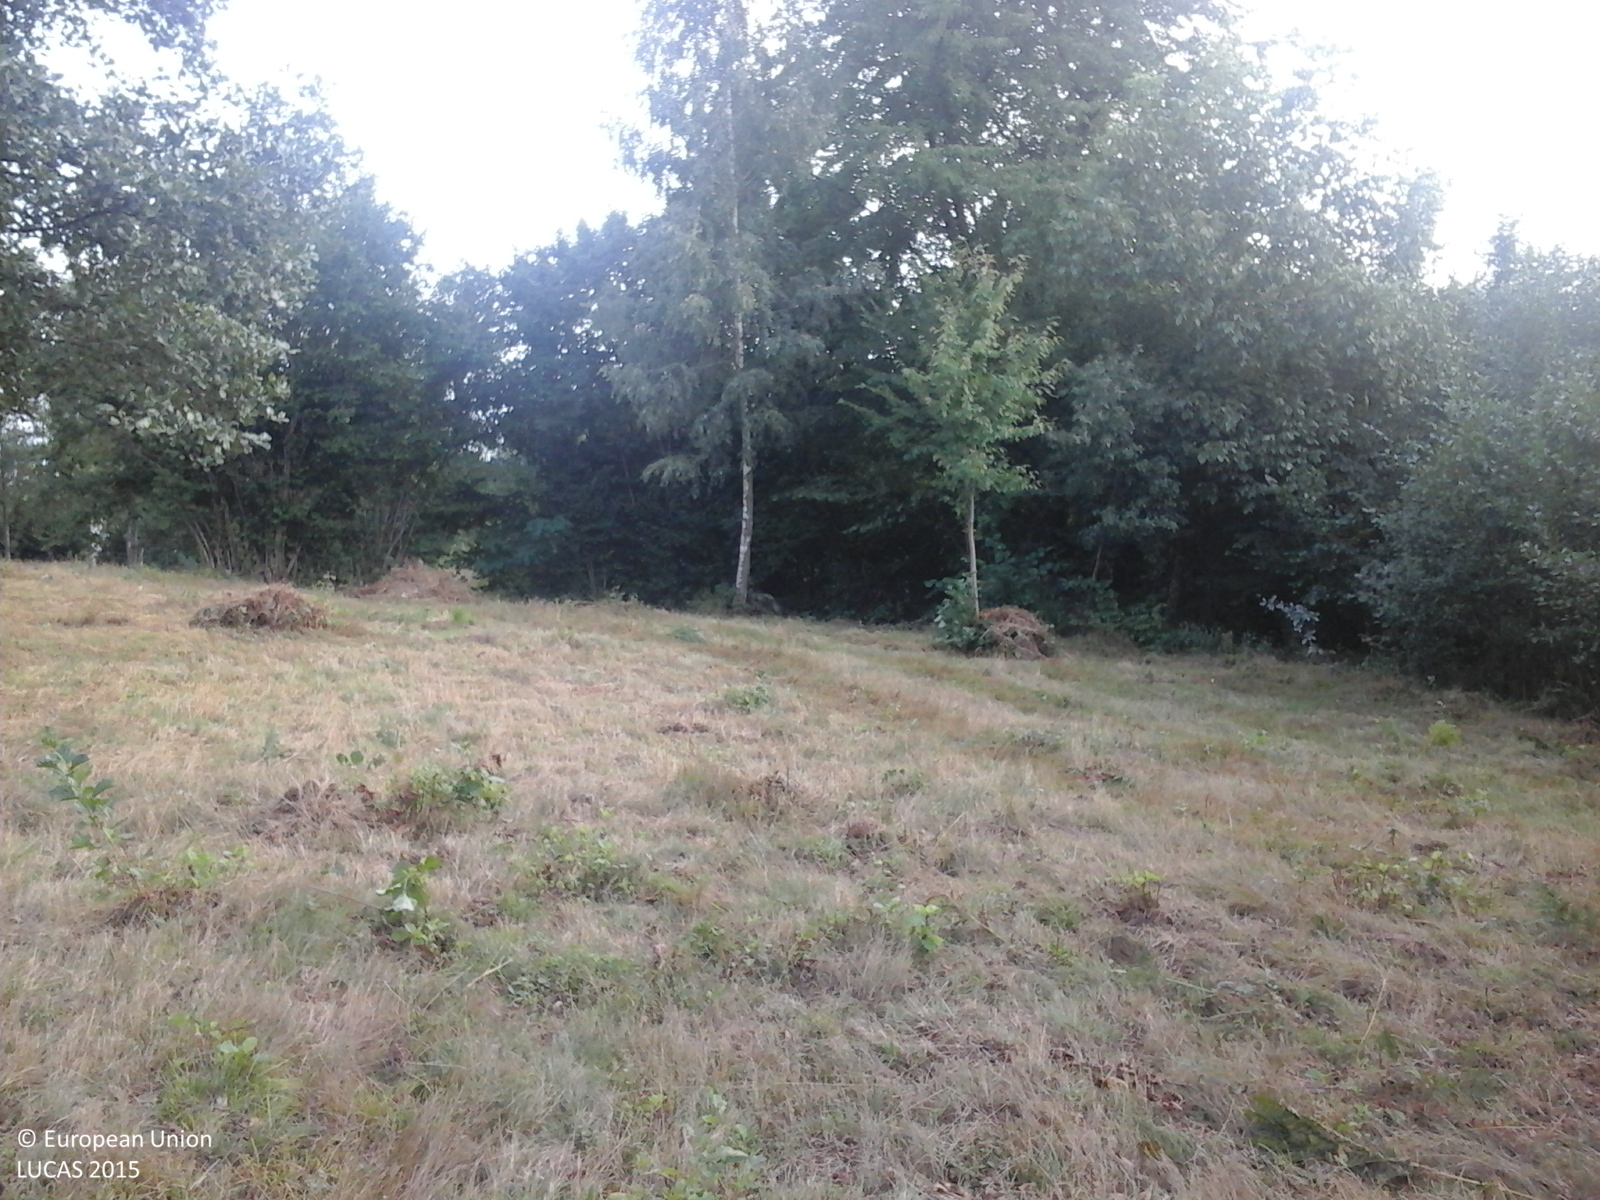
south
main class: Grassland
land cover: Grassland with sparse tree/shrub cover
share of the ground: > 75 %
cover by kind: herbaceous plants 85 %, shrubs 10 %, broadleaved forest trees 5 %
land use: Agriculture (excluding fallow land and kitchen gardens)
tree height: > 5 m
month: September
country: RO
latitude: 47.7831
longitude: 23.8425
